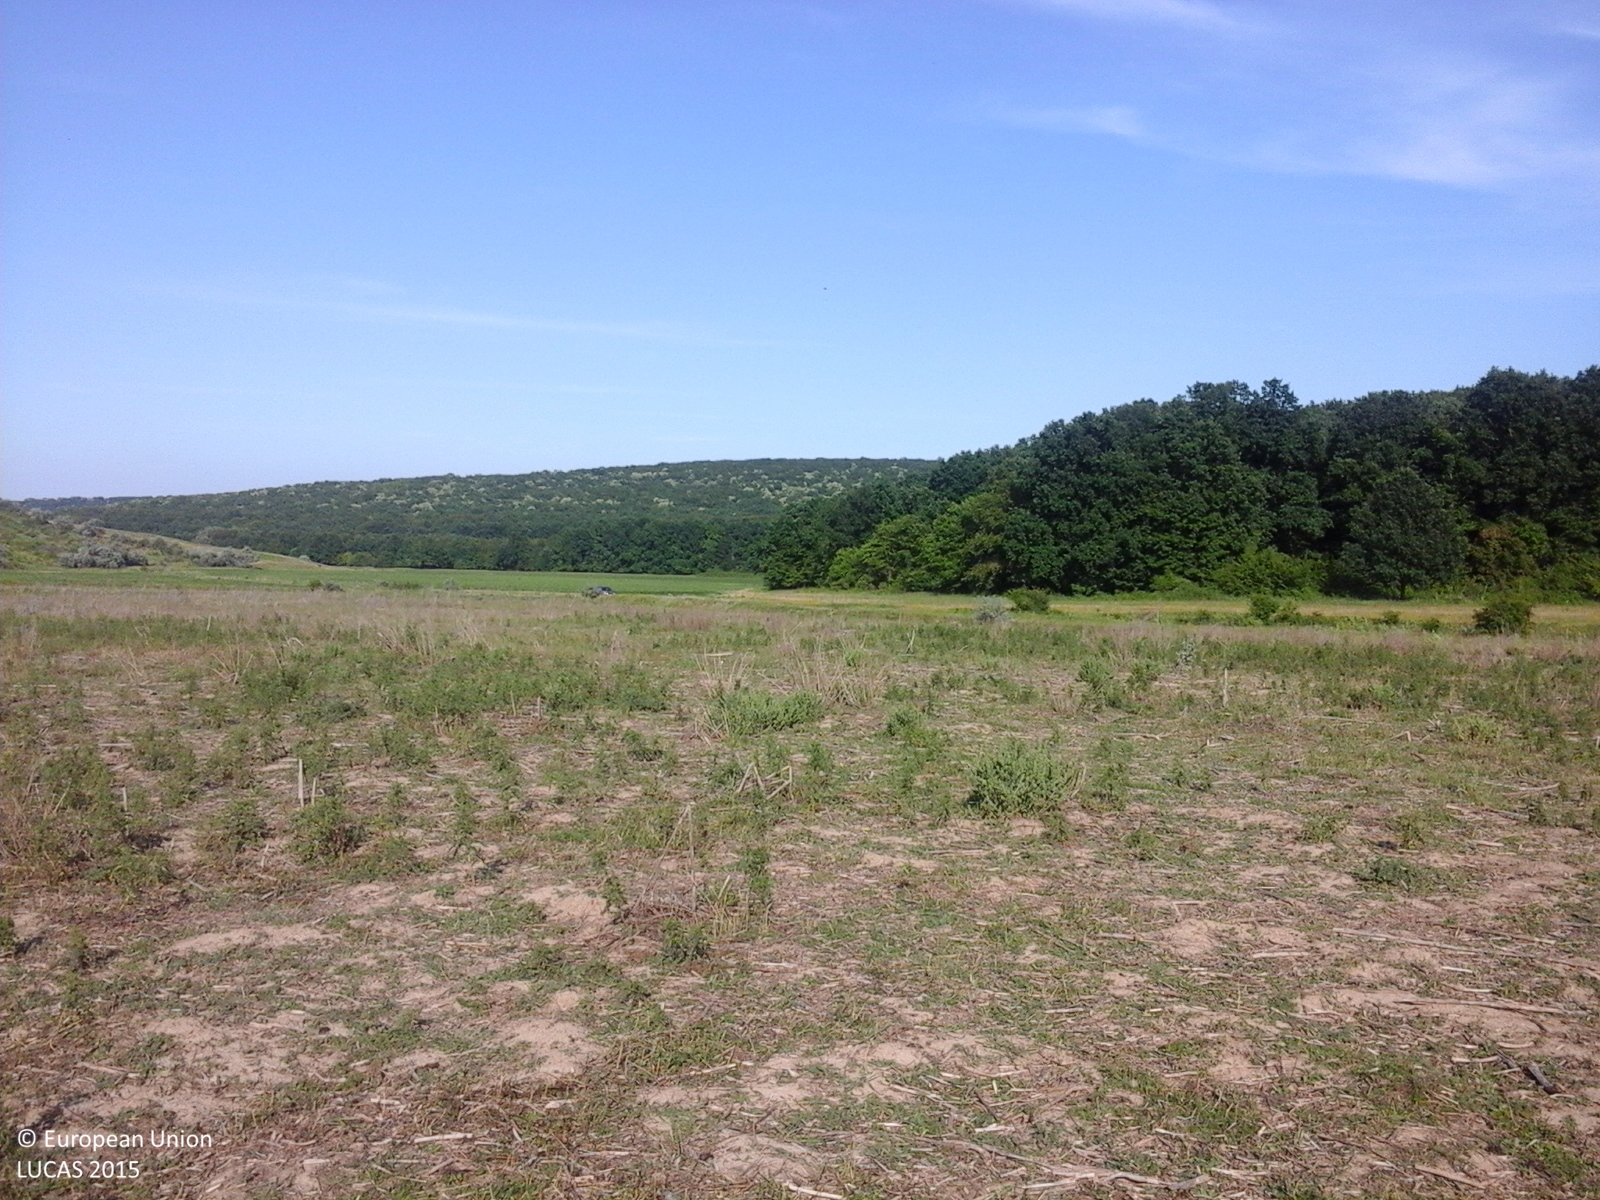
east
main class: Grassland
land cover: Spontaneously vegetated surfaces
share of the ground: > 75 %
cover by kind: herbaceous plants 100 %
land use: Agriculture (excluding fallow land and kitchen gardens)
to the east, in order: Spontaneously vegetated surfaces; Ditches and canals; Grassland without tree/shrub cover; Tracks; Grass margins; Soya
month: June
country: RO
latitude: 47.1269
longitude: 27.0139
